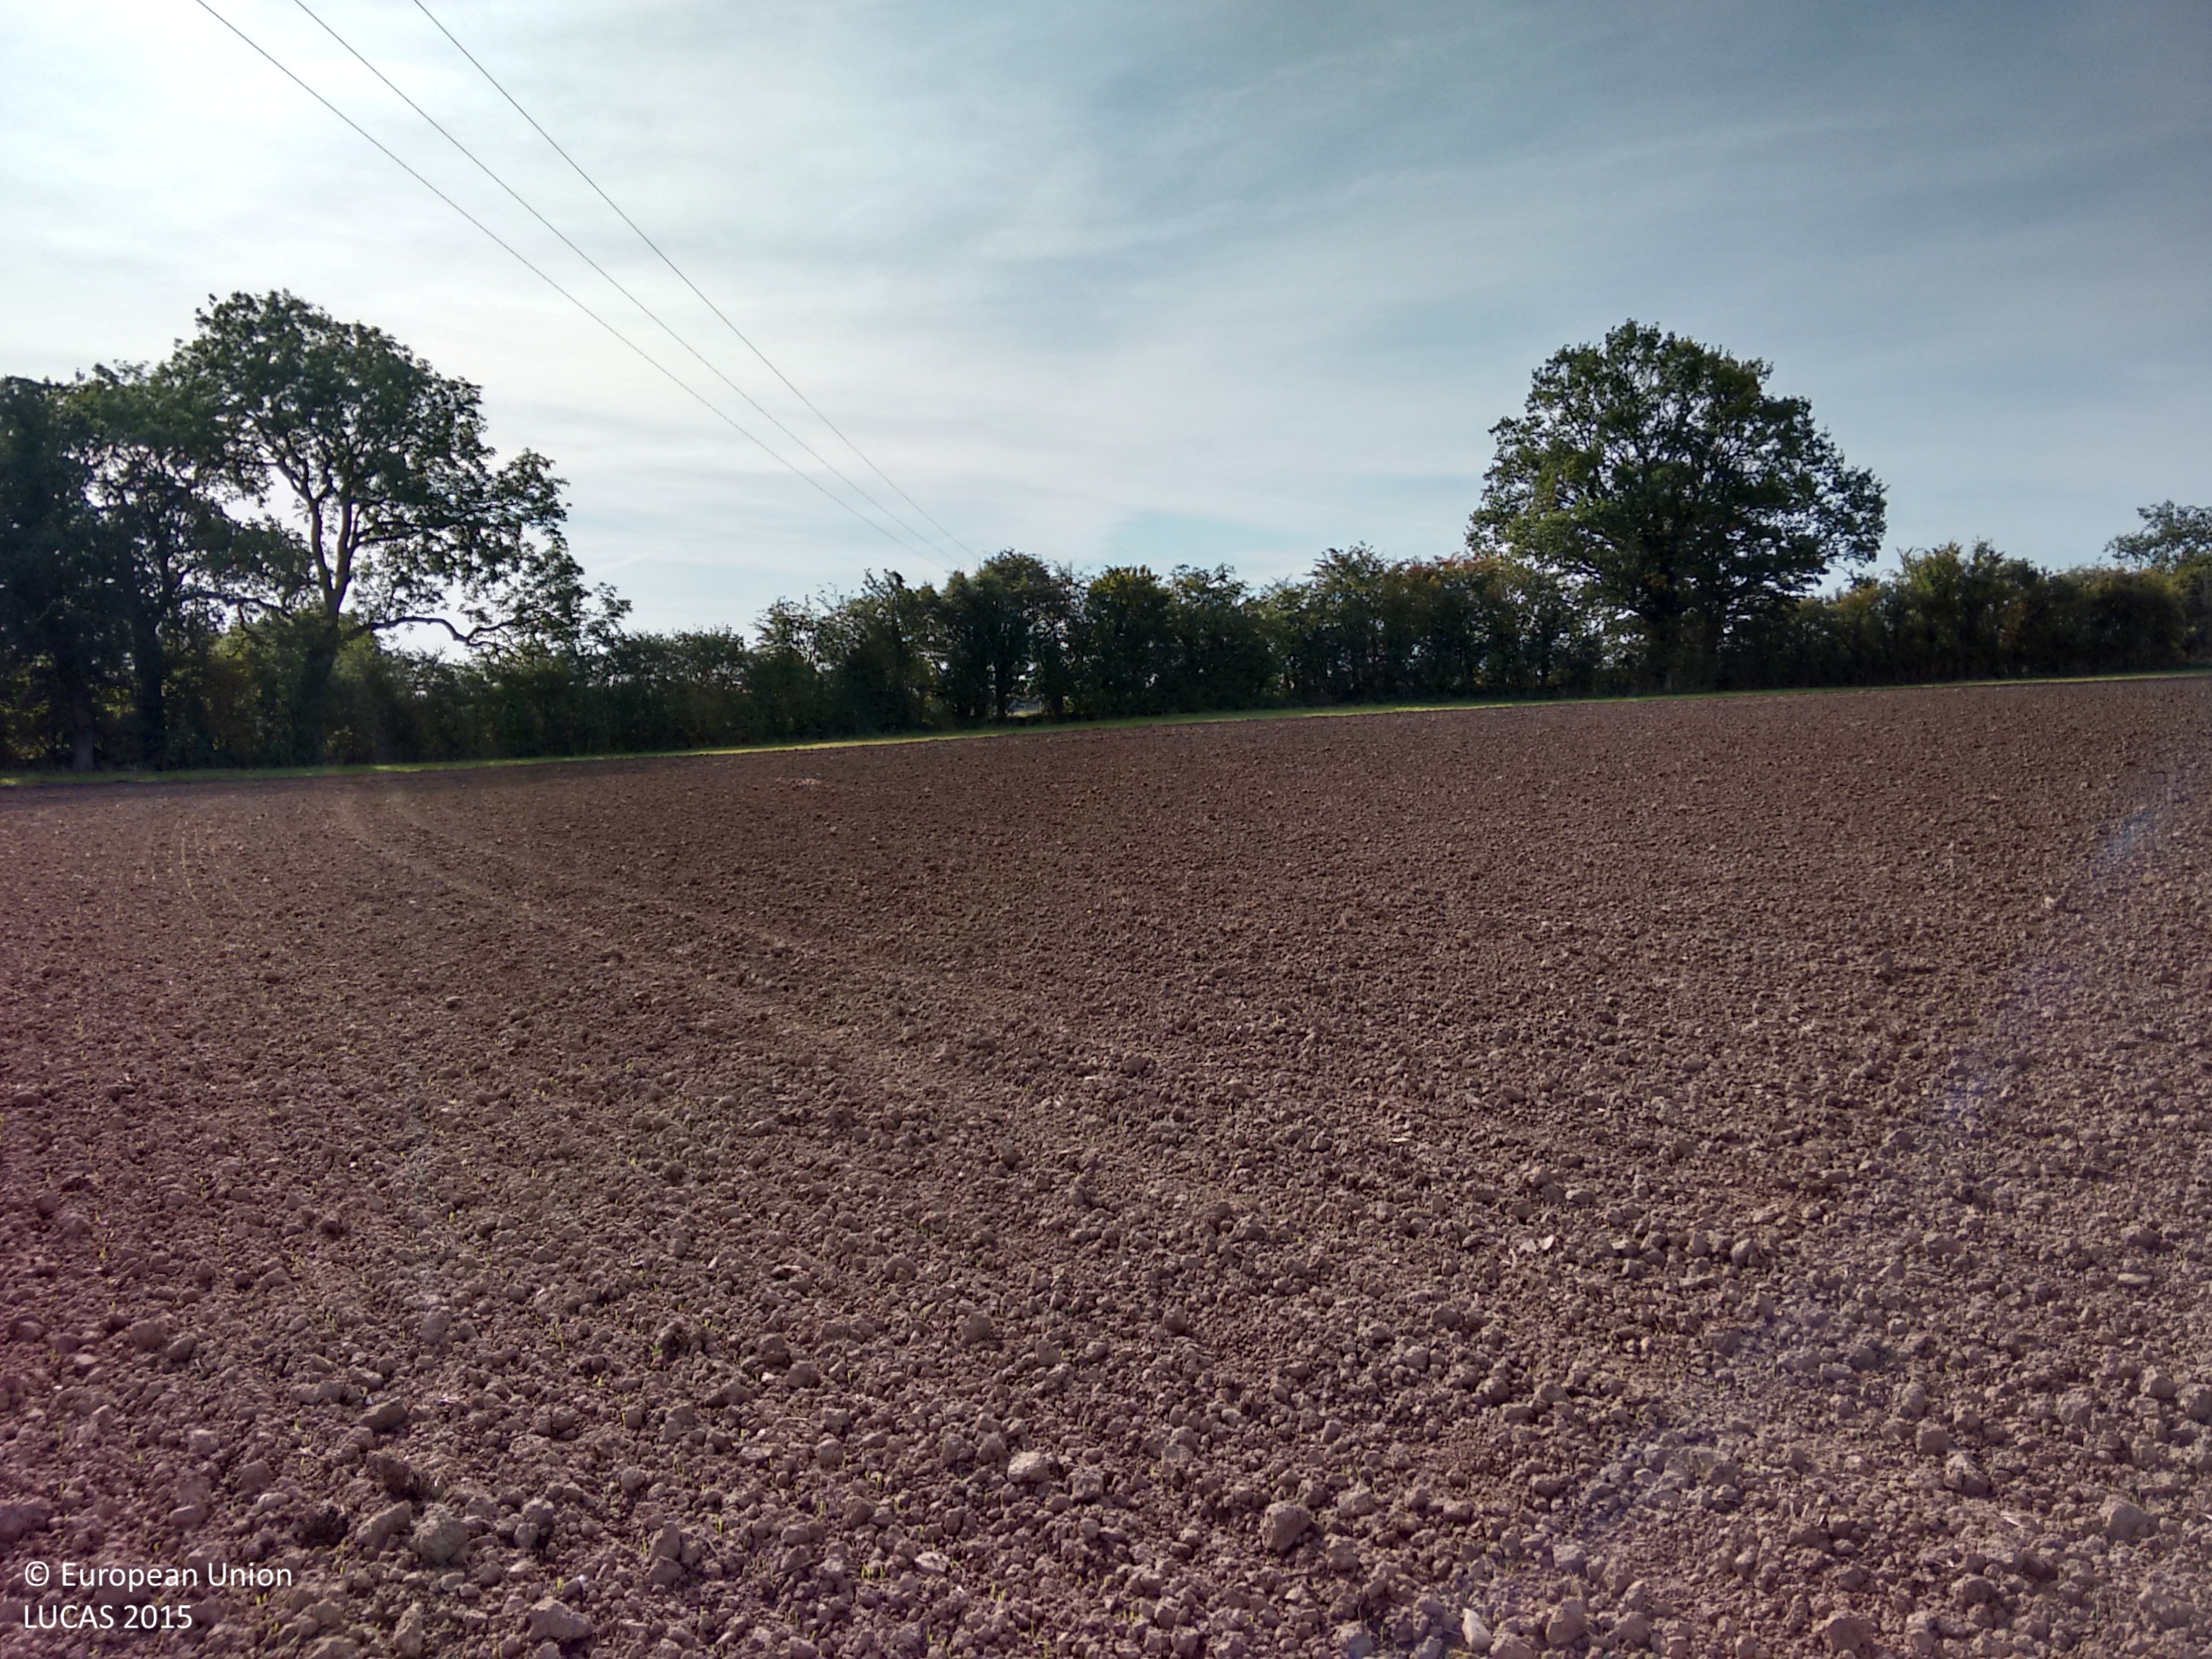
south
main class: Cropland
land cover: Barley
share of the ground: < 10 %
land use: Agriculture (excluding fallow land and kitchen gardens)
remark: Tilled/Sowed
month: September
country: GB
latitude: 51.5783
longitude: -2.4028
